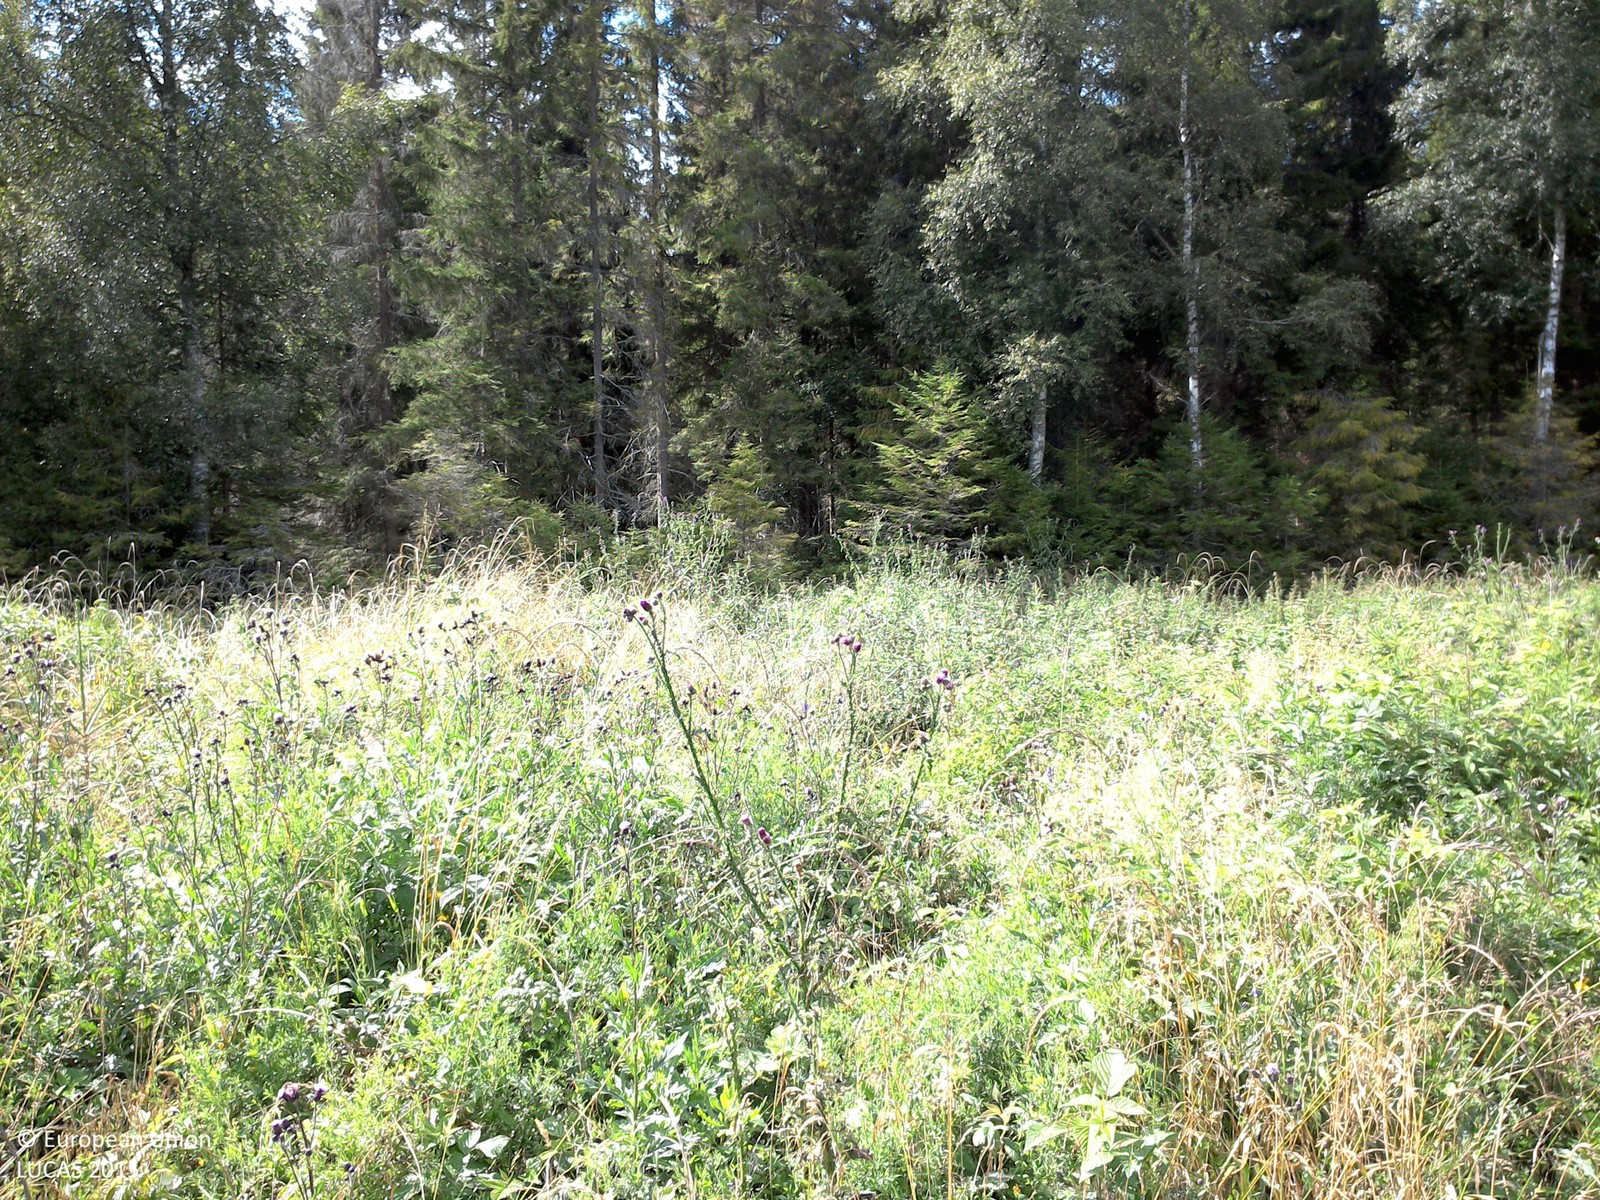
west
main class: Shrubland
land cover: Shrubland without tree cover
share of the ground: > 75 %
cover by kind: shrubs 90 %, herbaceous plants 10 %
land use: Forestry
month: August
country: SE
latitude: 58.1660
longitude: 14.9069
